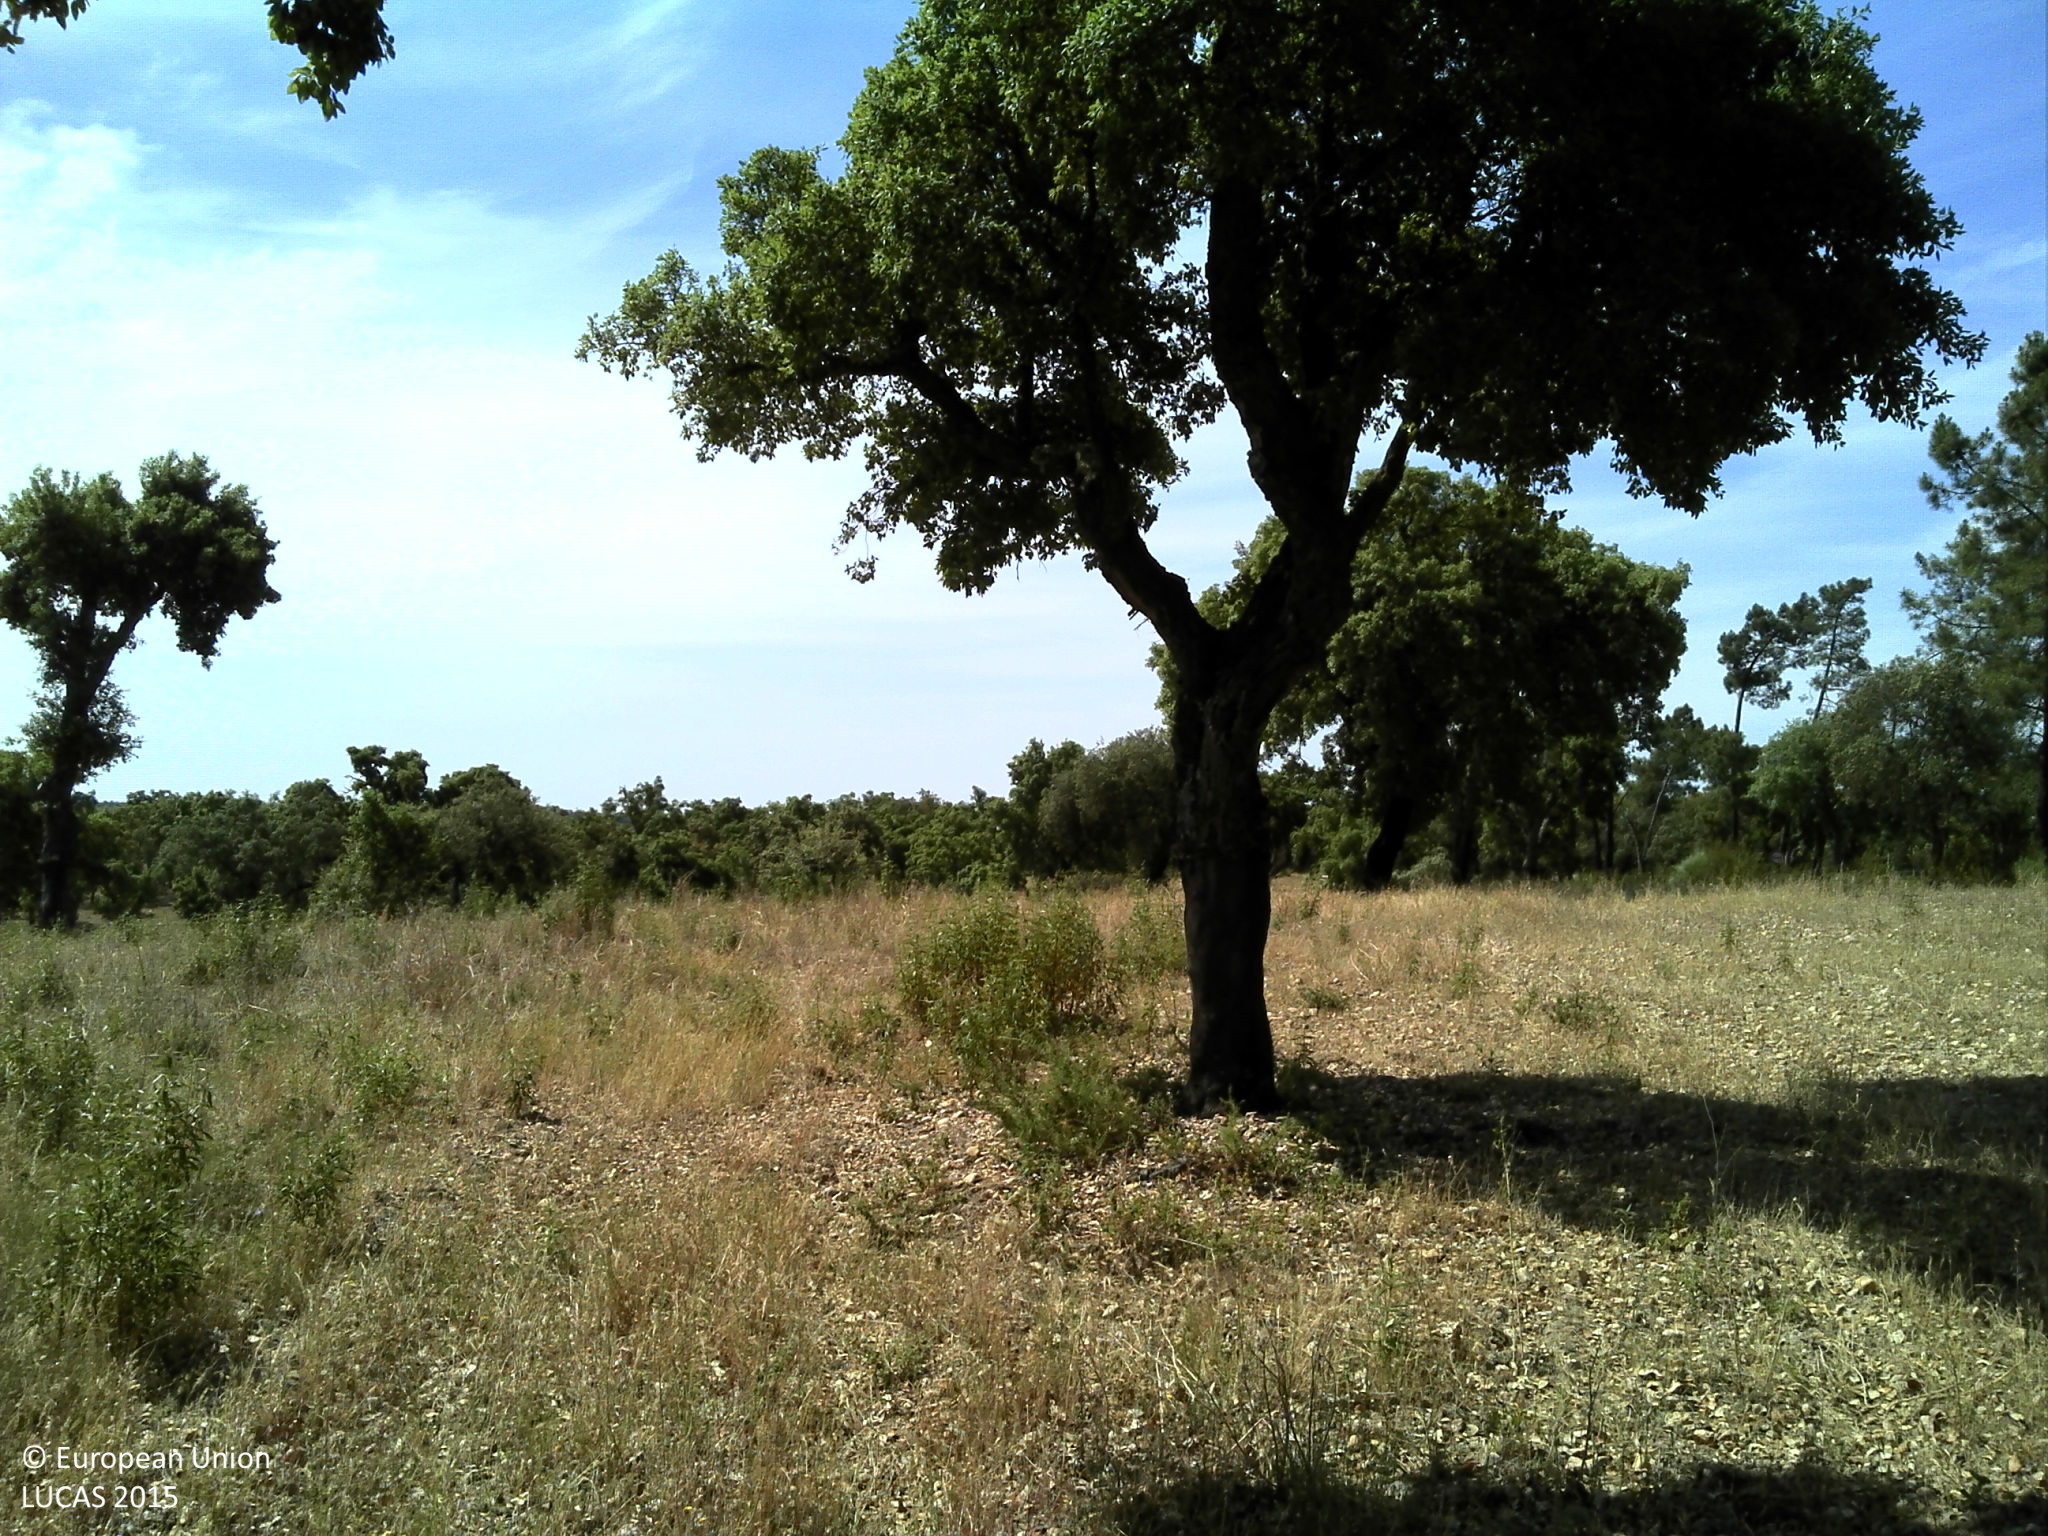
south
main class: Woodland
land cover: Broadleaved woodland
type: broadleaved evergreen forest
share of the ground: 25 - 50 %
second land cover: Grassland without tree/shrub cover
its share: 10 - 25 %
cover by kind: broadleaved forest trees 40 %, unconsolidated bare surface 30 %, herbaceous plants 25 %, shrubs 5 %
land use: Forestry
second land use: Agriculture (excluding fallow land and kitchen gardens)
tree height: > 5 m
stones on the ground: < 10 %
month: May
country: PT
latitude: 39.2861
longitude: -7.9188
